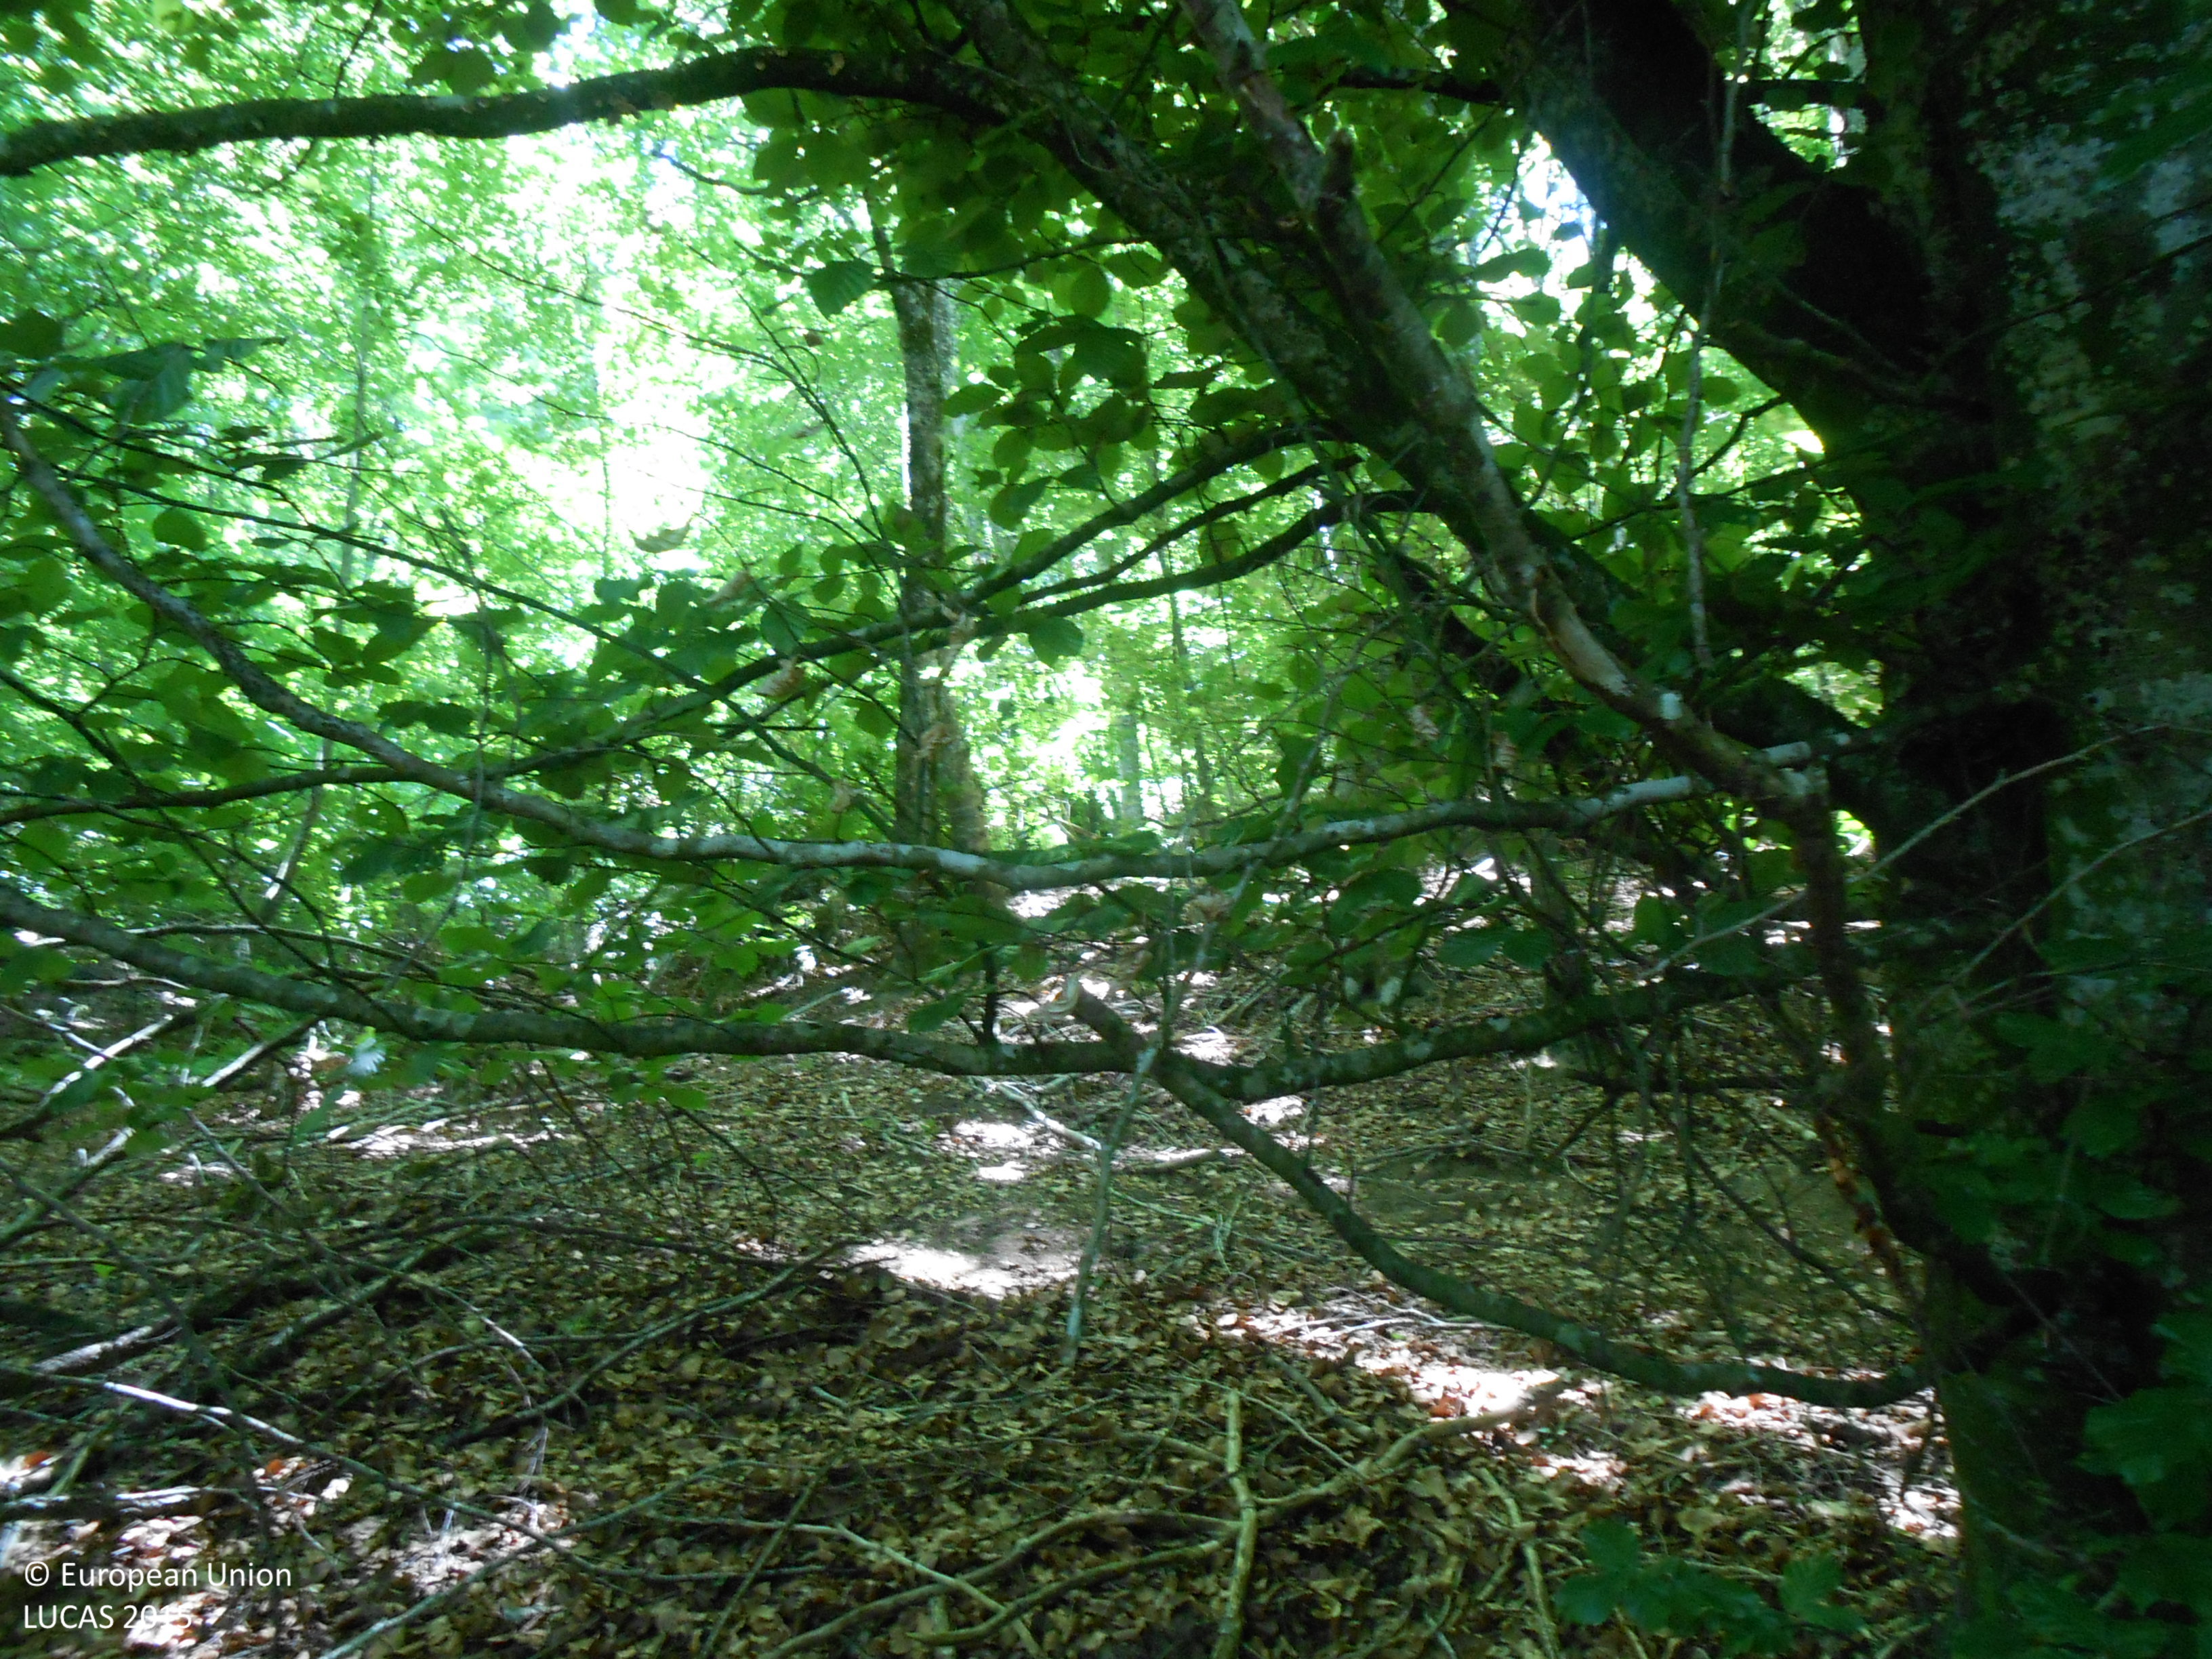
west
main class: Woodland
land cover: Broadleaved woodland
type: beech forest
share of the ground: > 75 %
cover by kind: broadleaved forest trees 100 %
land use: Forestry
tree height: > 5 m
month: June
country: ES
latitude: 42.9578
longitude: -1.6986
